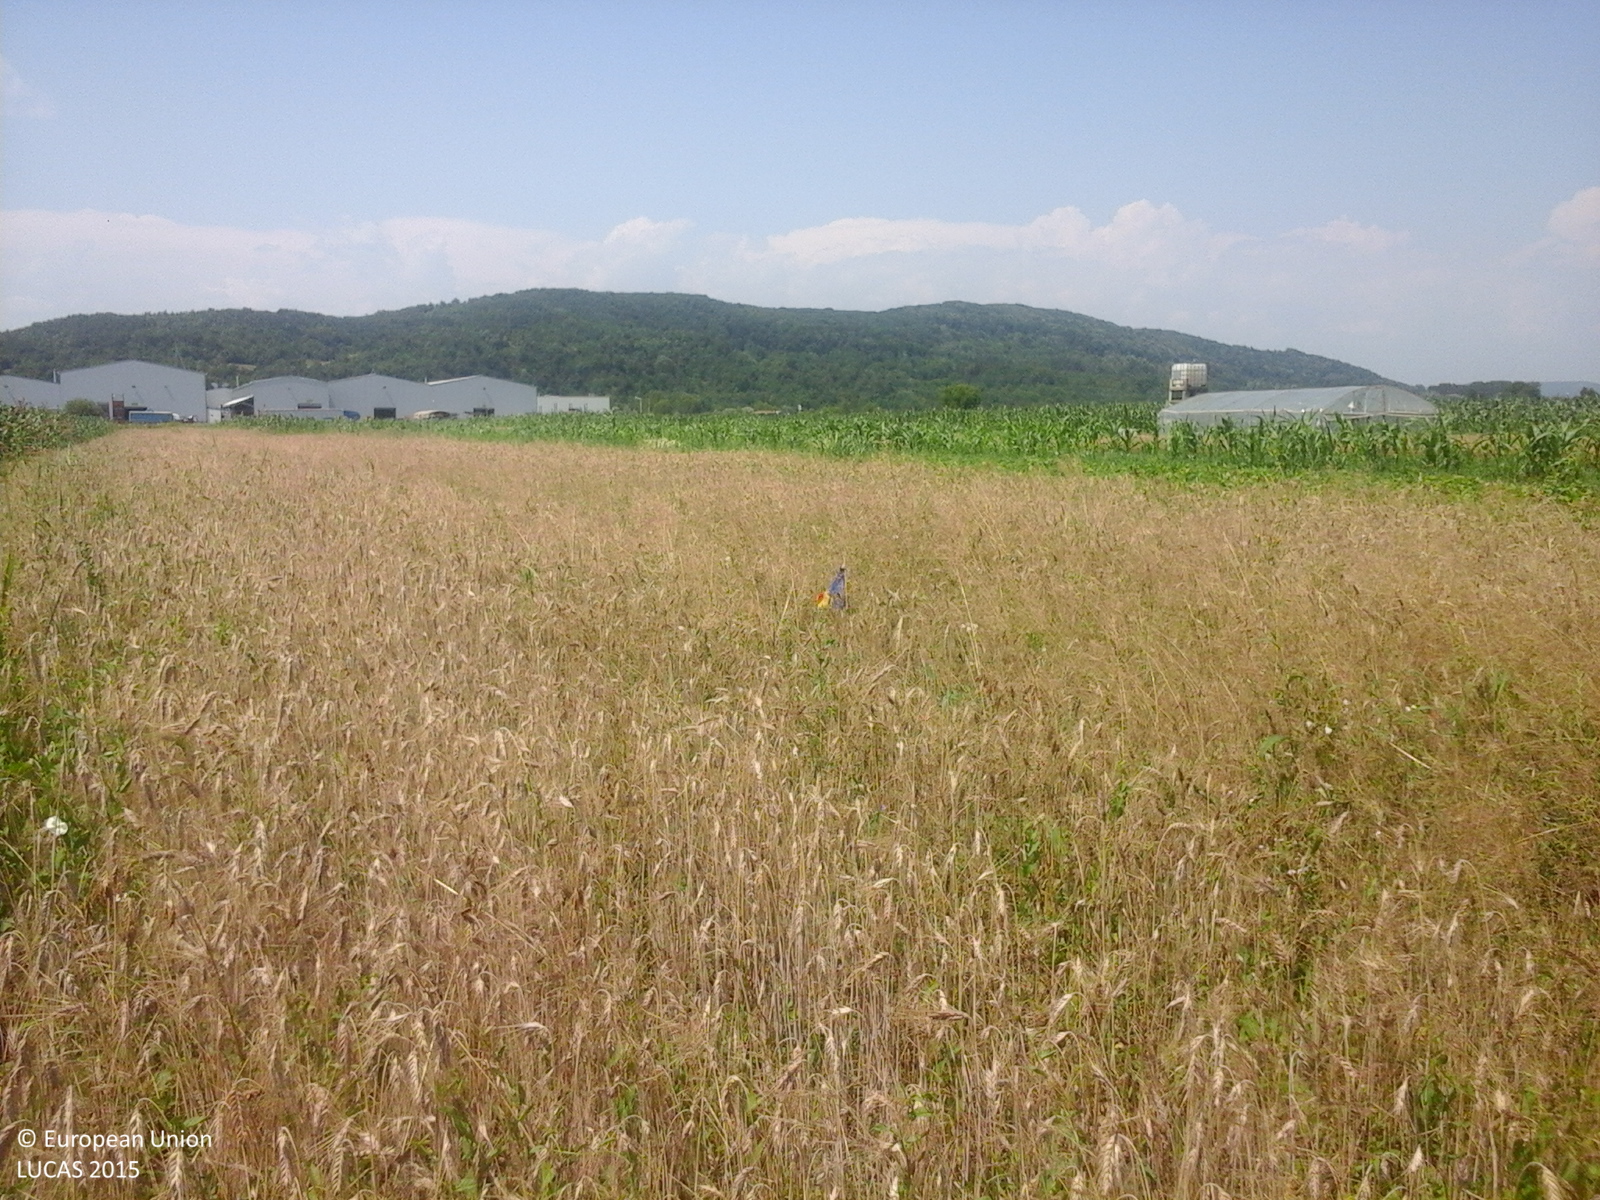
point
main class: Cropland
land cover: Common wheat
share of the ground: > 75 %
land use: Agriculture (excluding fallow land and kitchen gardens)
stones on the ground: < 10 %
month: July
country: RO
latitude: 44.9665
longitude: 24.9303
